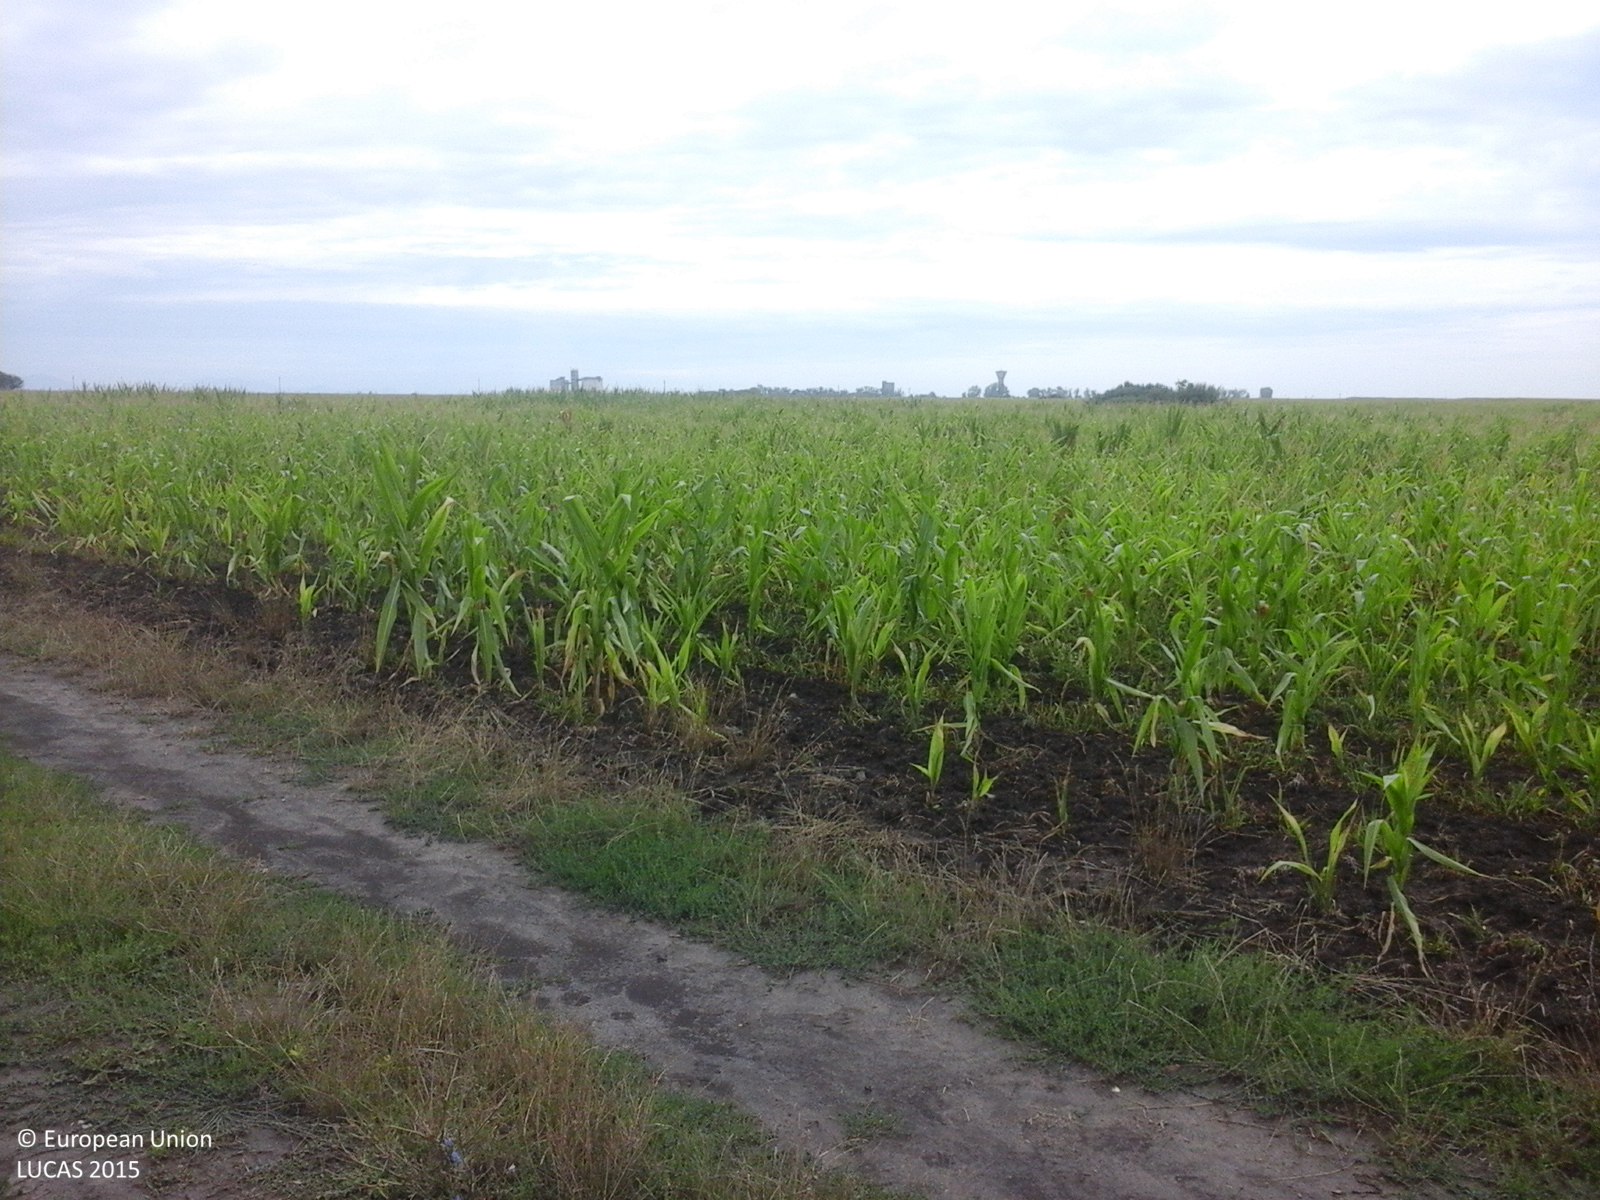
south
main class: Grassland
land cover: Grassland without tree/shrub cover
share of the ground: > 75 %
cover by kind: herbaceous plants 100 %
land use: Agriculture (excluding fallow land and kitchen gardens)
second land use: Sport
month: August
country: RO
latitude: 45.4571
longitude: 21.3217
